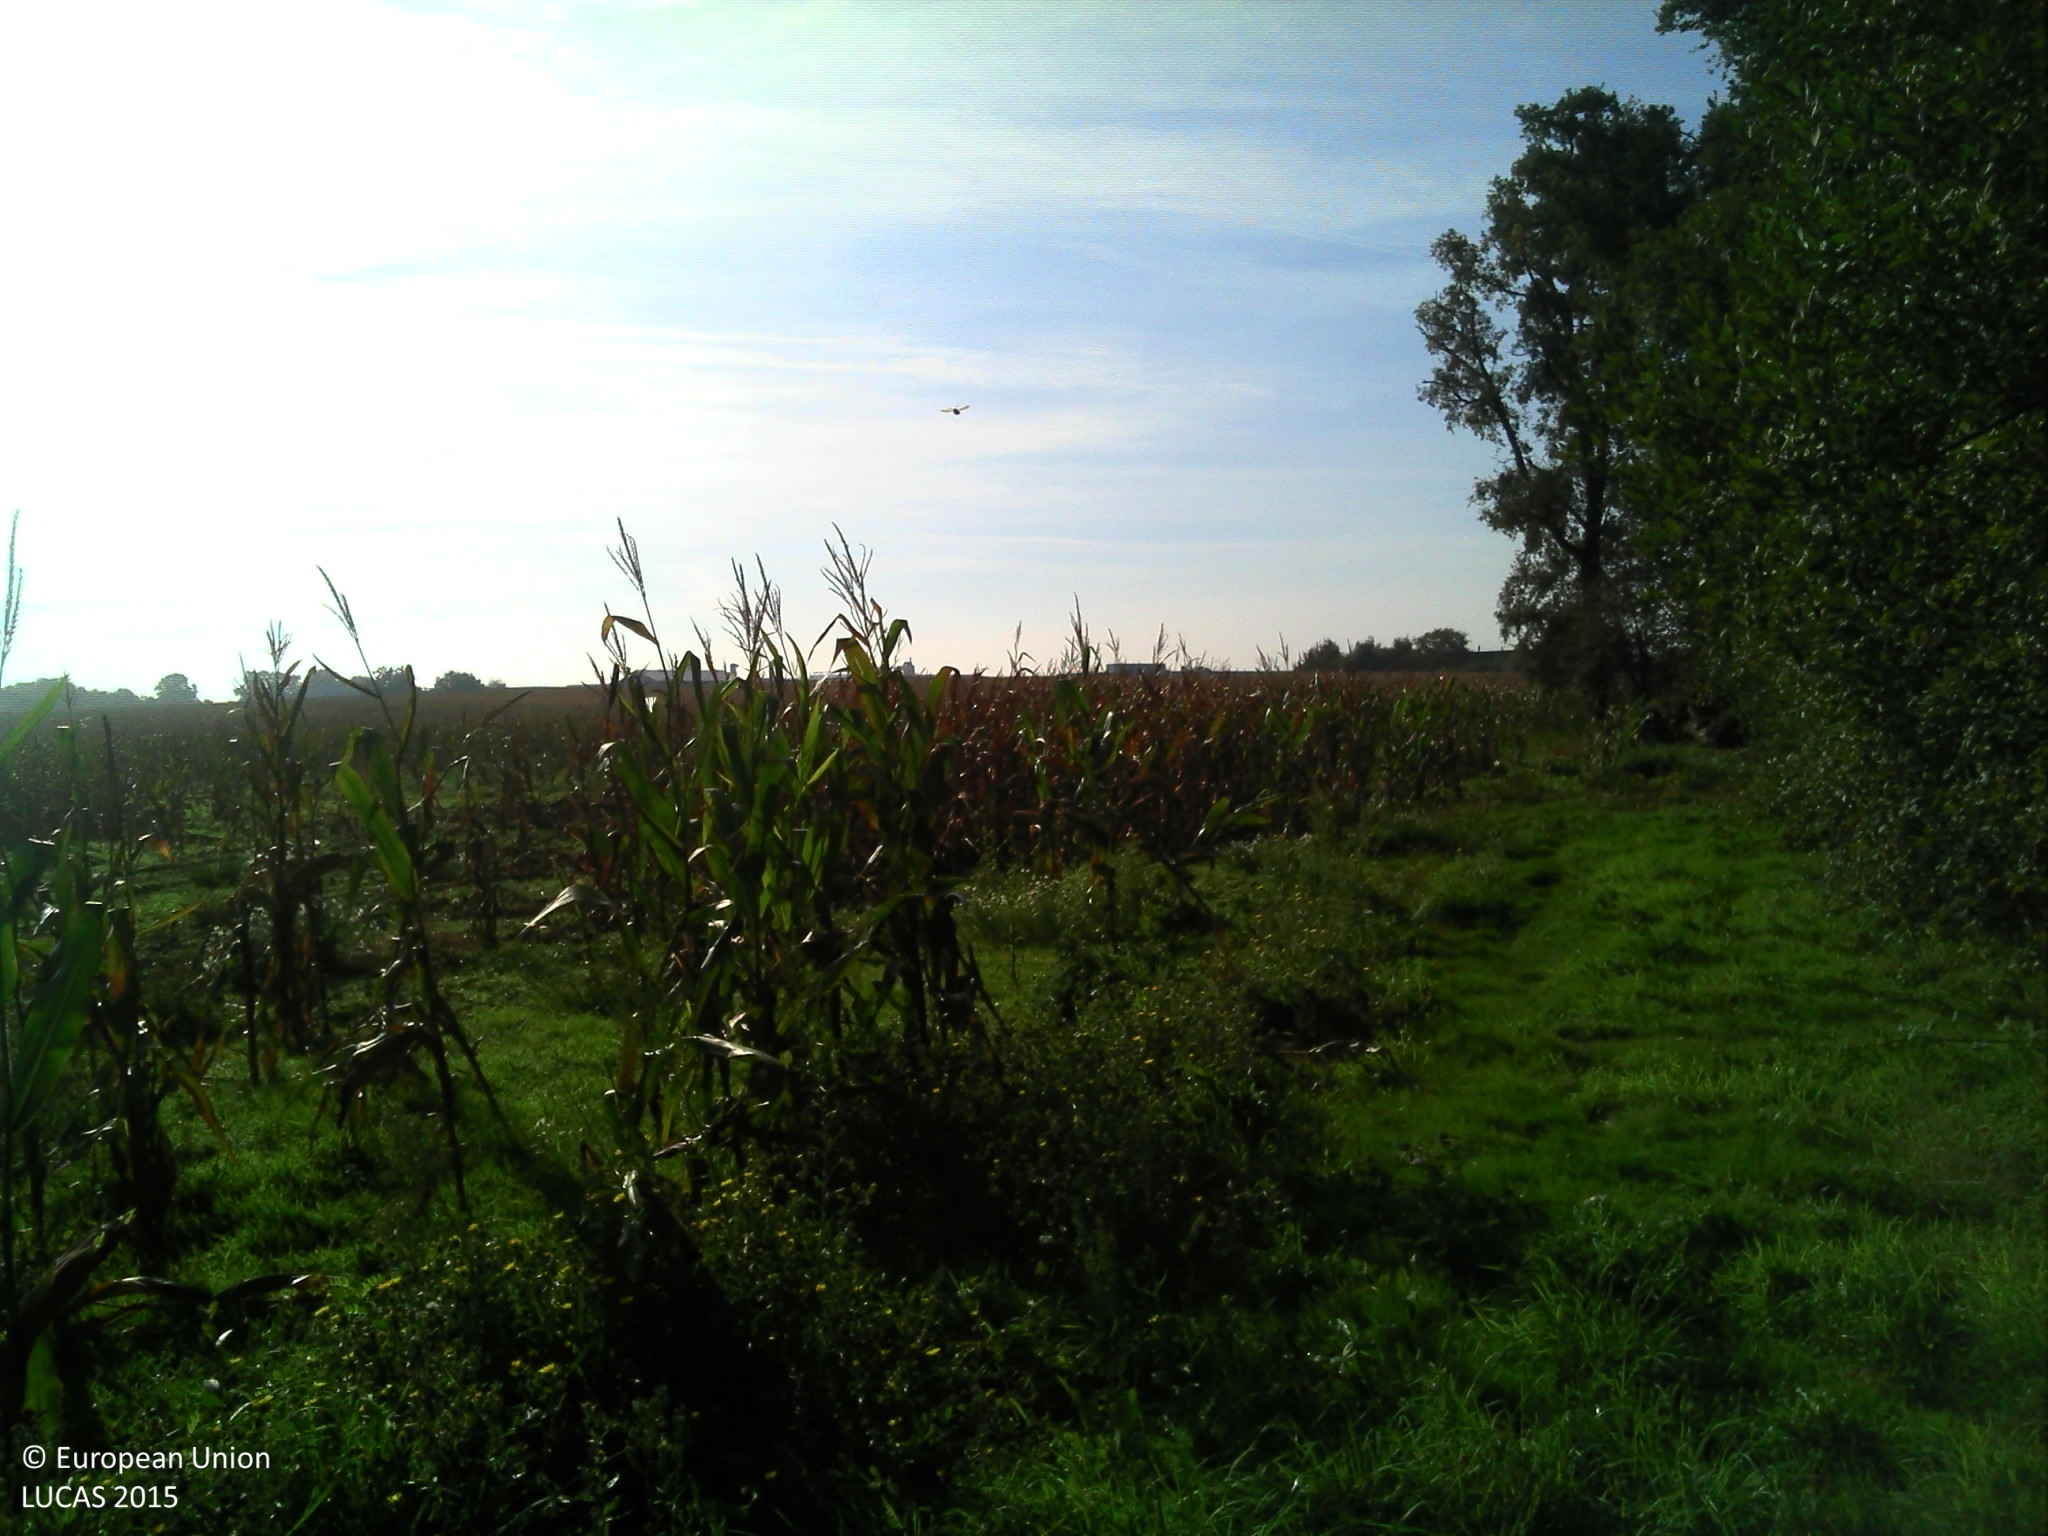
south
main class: Woodland
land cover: Broadleaved woodland
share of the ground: > 75 %
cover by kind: broadleaved forest trees 95 %, shrubs 5 %
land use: Semi-natural and natural areas not in use
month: October
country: FR
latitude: 47.2191
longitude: -0.9822
